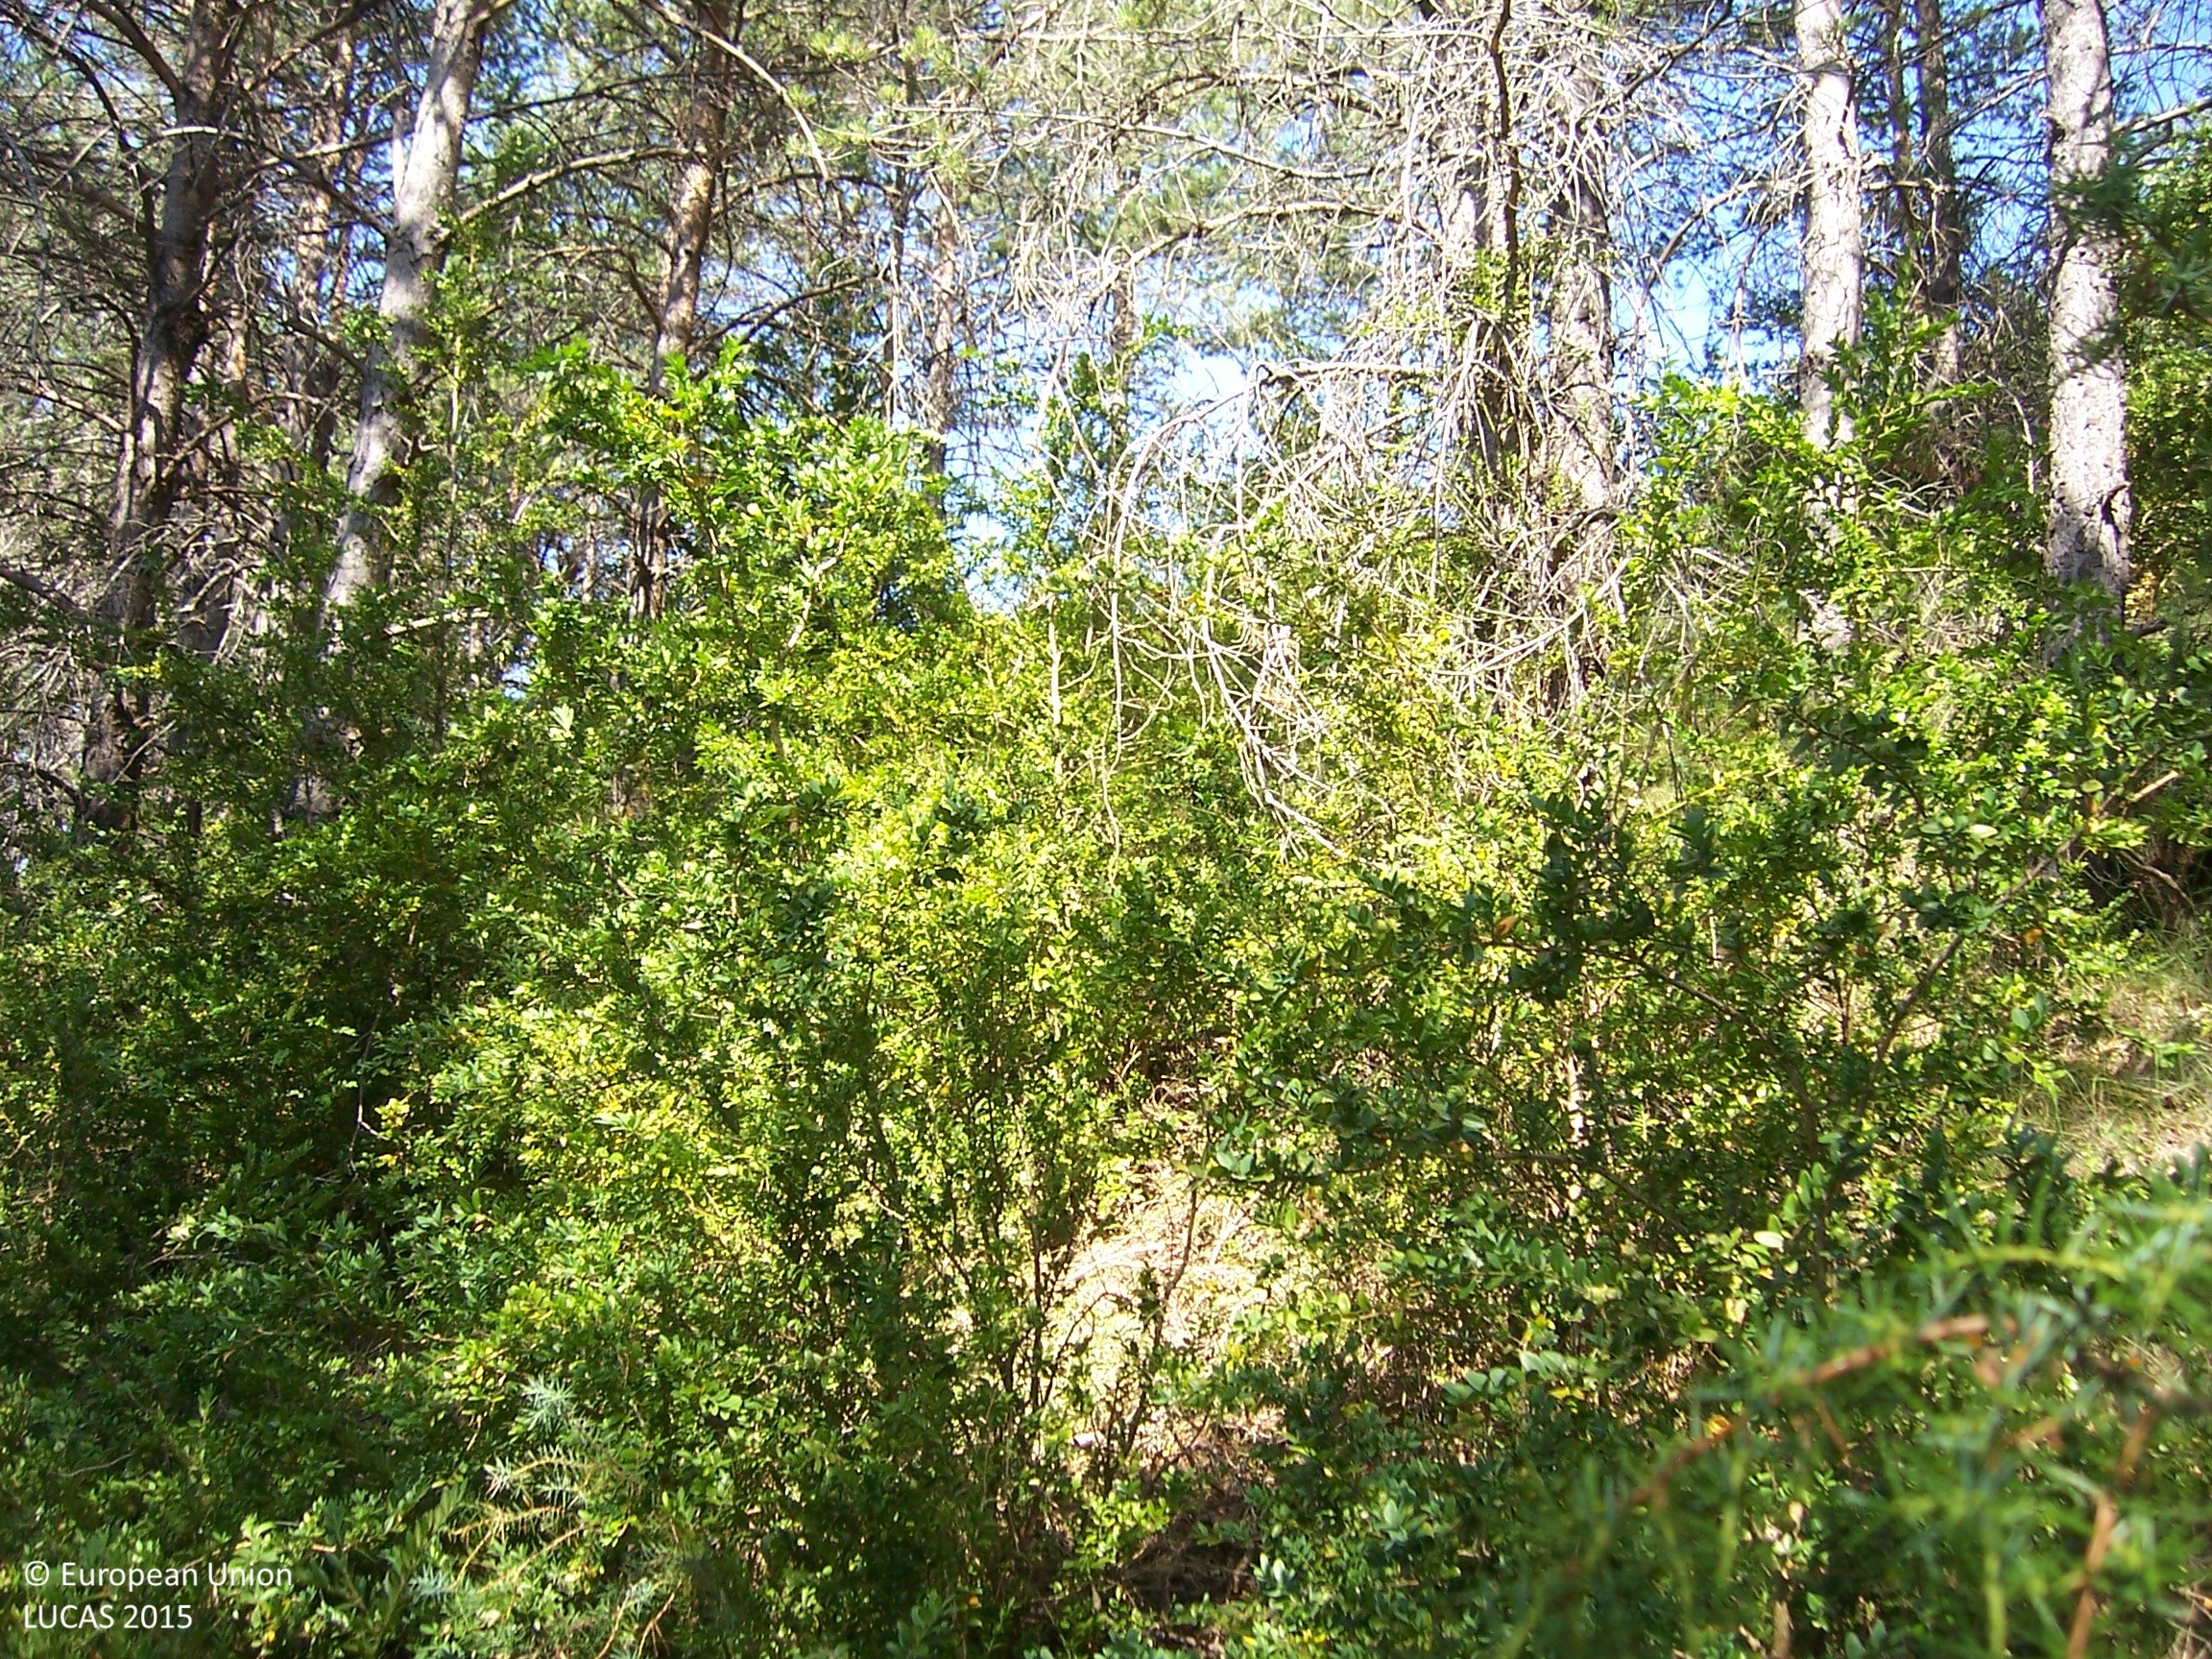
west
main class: Woodland
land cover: Pine dominated coniferous woodland
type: coniferous forest of the mediterranean region
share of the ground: > 75 %
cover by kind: coniferous forest trees 100 %
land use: Forestry
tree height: > 5 m
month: July
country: ES
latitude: 42.7631
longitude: -1.1663
